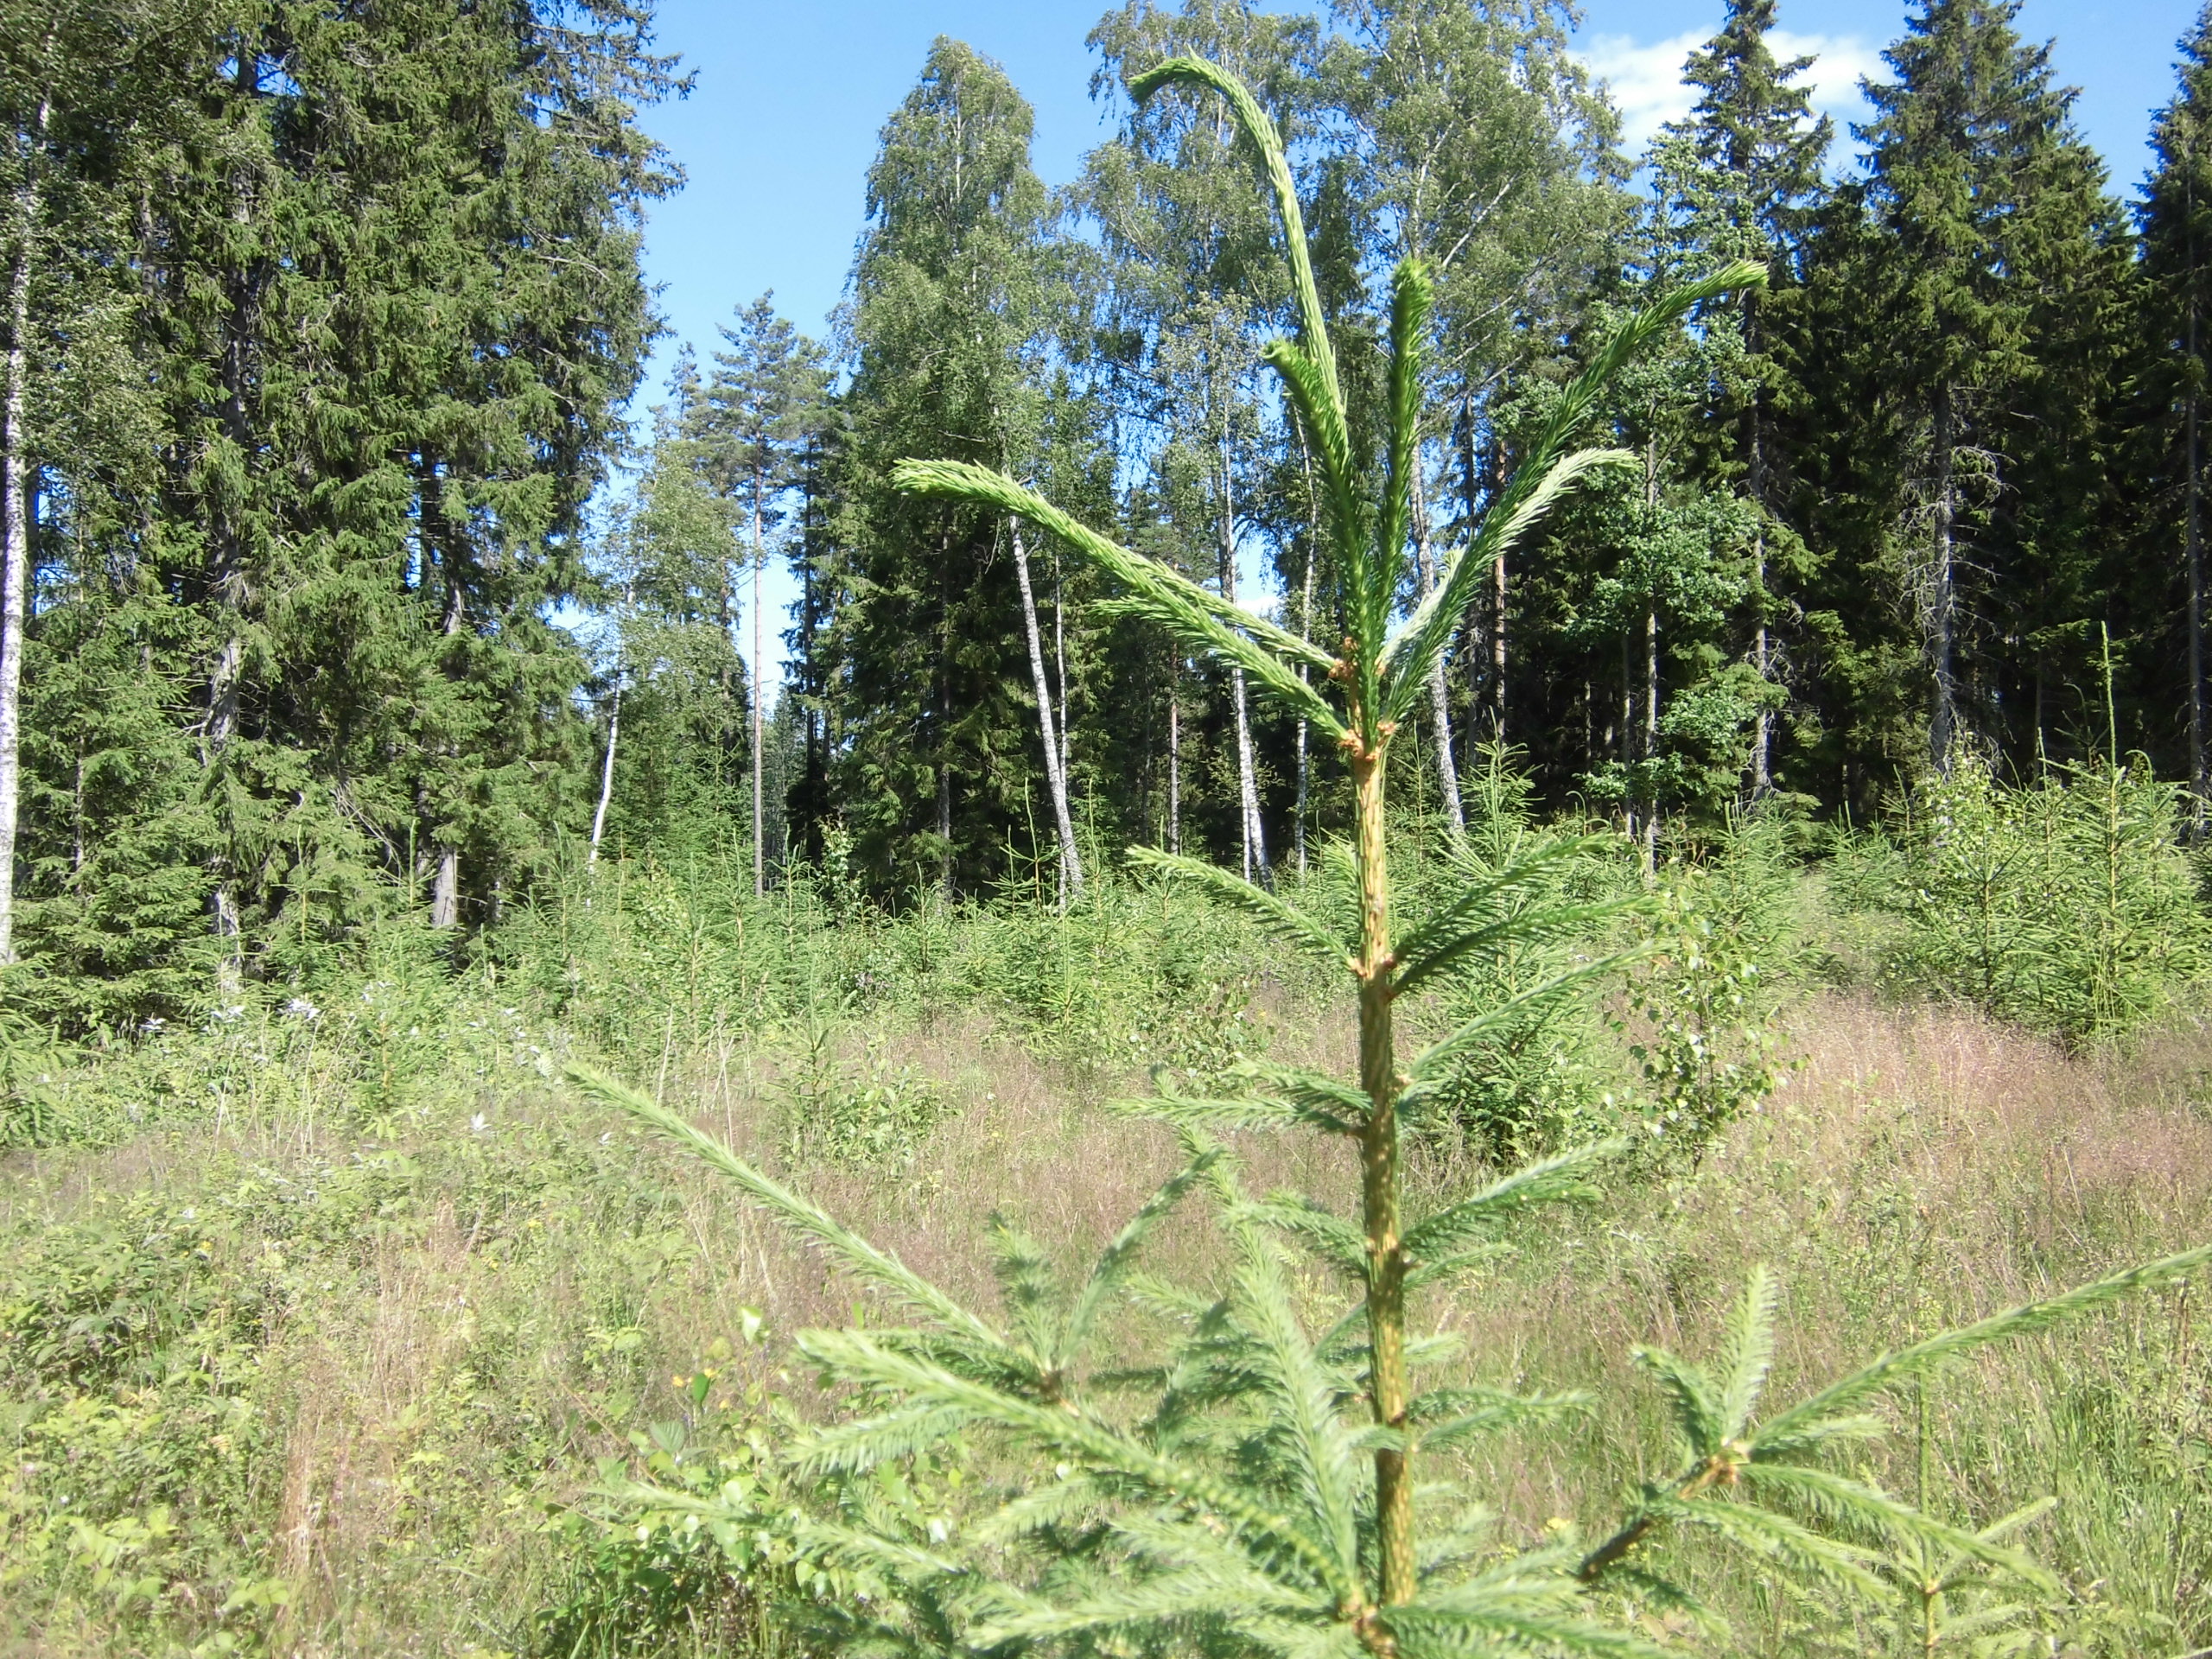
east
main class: Woodland
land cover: Spruce dominated mixed woodland
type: boreal forest
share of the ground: 25 - 50 %
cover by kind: herbaceous plants 35 %, shrubs 30 %, coniferous forest trees 15 %, broadleaved forest trees 15 %, lichens and mosses 5 %
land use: Forestry
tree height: < 5 m
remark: Clear cut
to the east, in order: Spruce dominated mixed woodland; Spruce dominated coniferous woodland; Paved roads, cycling and walking lanes; Spruce dominated coniferous woodland; Tracks; Spruce dominated coniferous woodland; Ditches and canals; Spruce dominated coniferous woodland; Spruce dominated mixed woodland; Ditches and canals; Spruce dominated mixed woodland
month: July
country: SE
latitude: 57.2822
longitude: 15.3884
